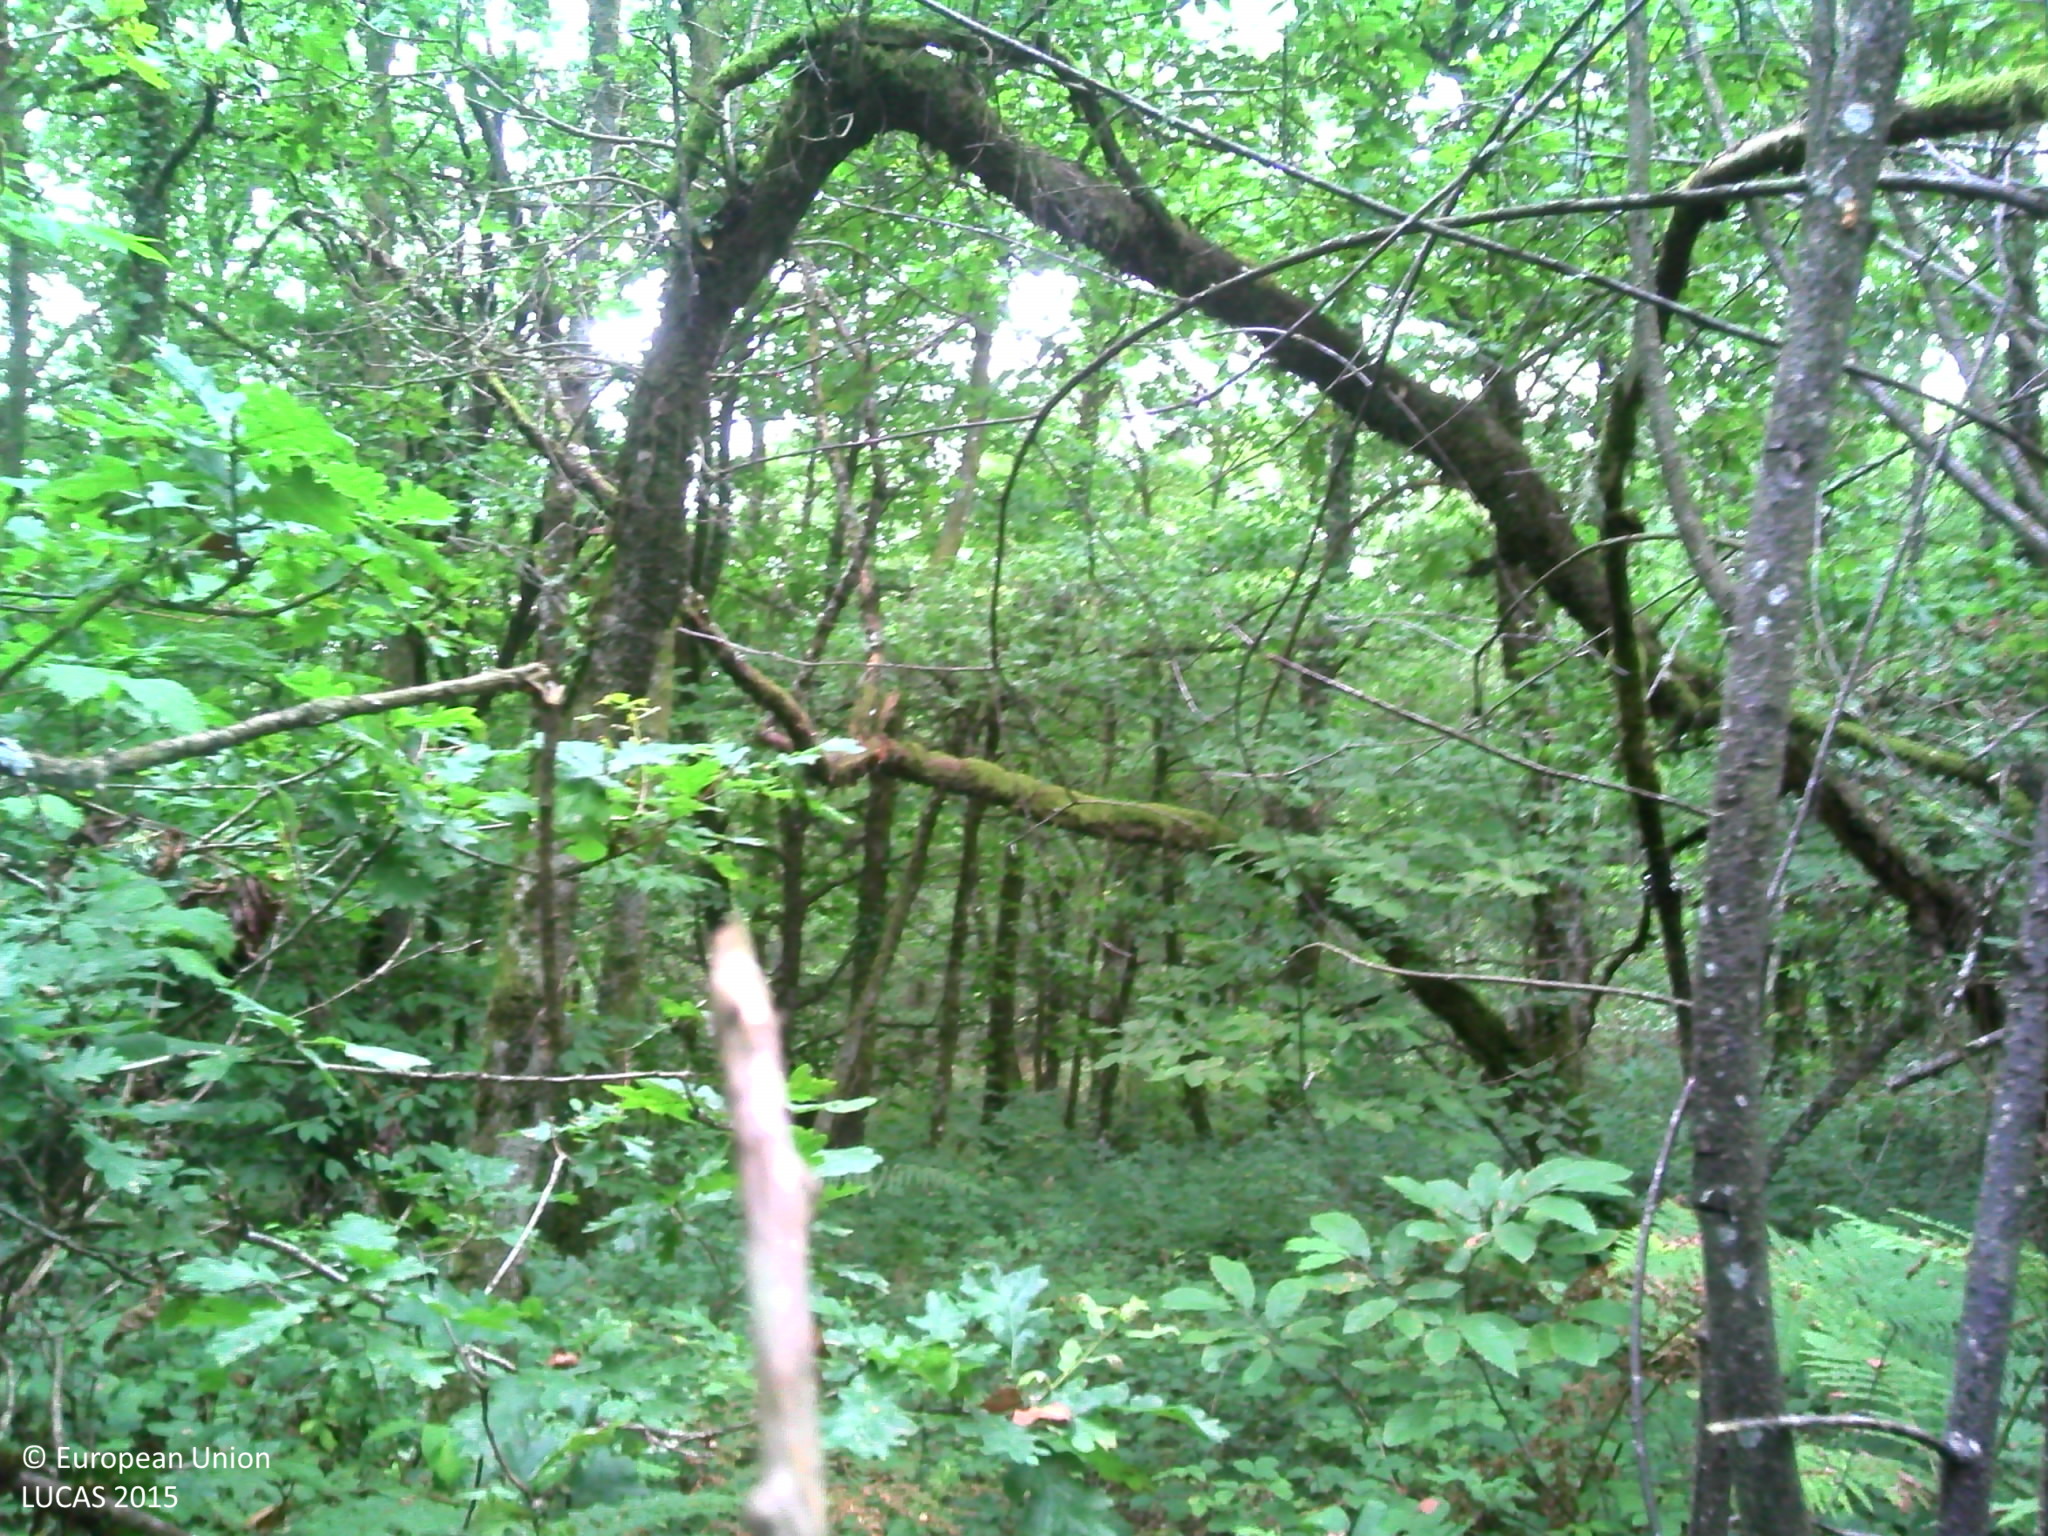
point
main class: Woodland
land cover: Broadleaved woodland
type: mesophytic deciduous forest
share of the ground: > 75 %
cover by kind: broadleaved forest trees 85 %, herbaceous plants 15 %
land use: Forestry
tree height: > 5 m
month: August
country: FR
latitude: 46.0404
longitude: 1.3978
